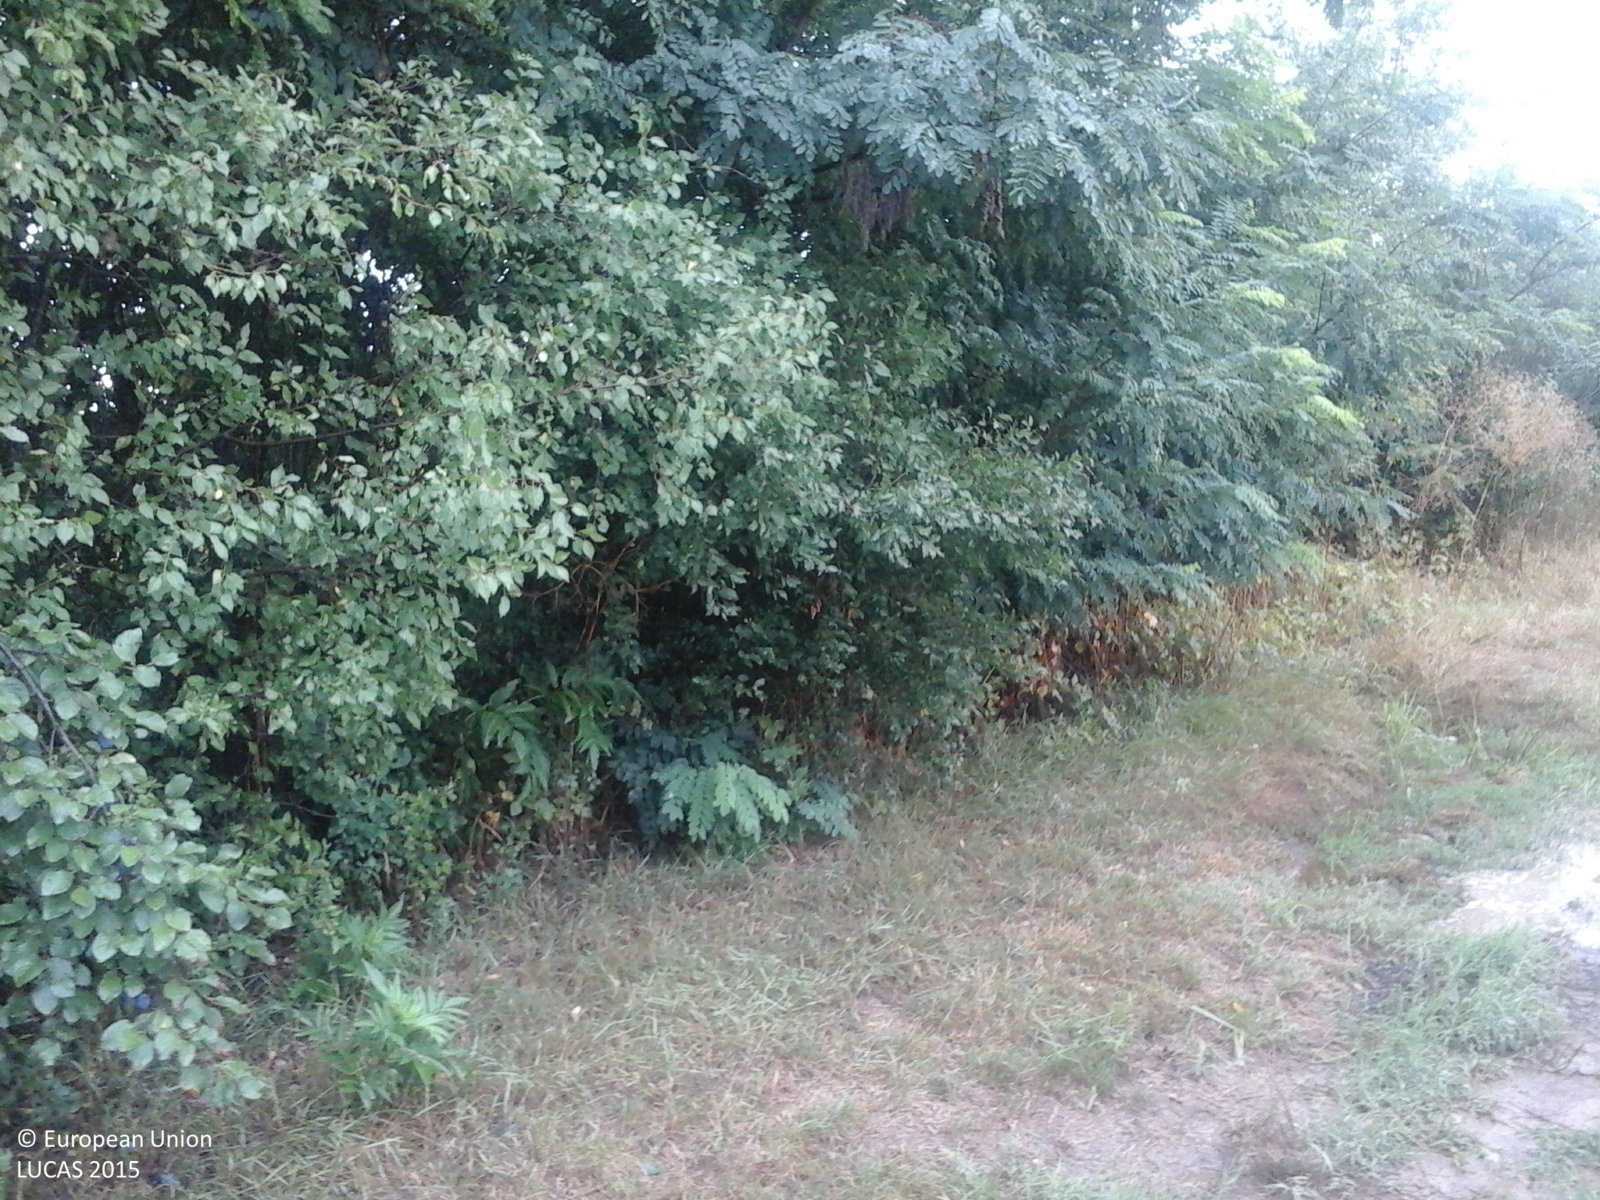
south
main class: Cropland
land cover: Maize
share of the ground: > 75 %
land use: Agriculture (excluding fallow land and kitchen gardens)
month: August
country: RO
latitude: 45.7587
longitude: 21.7232
